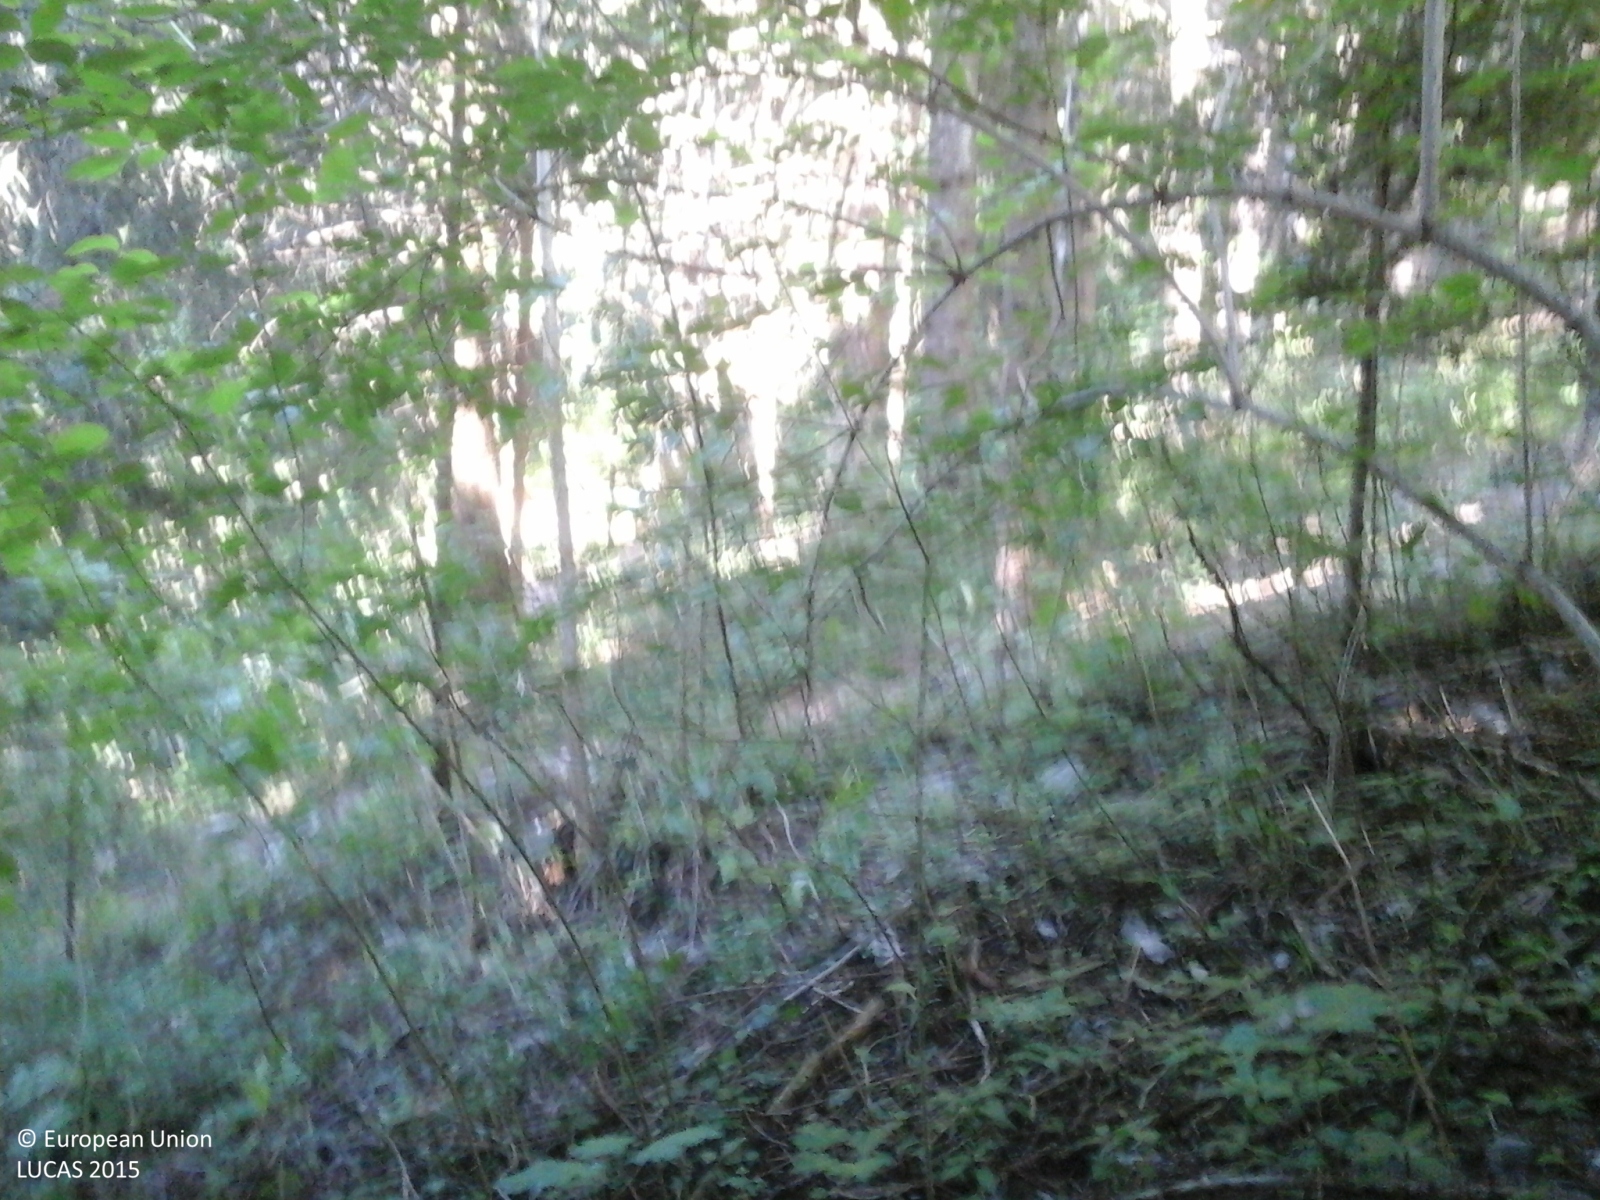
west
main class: Woodland
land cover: Spruce dominated coniferous woodland
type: alpine coniferous forest
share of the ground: > 75 %
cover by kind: coniferous forest trees 100 %
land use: Forestry
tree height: > 5 m
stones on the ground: 10 - 25 %
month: May
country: IT
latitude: 46.1486
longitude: 10.9697
